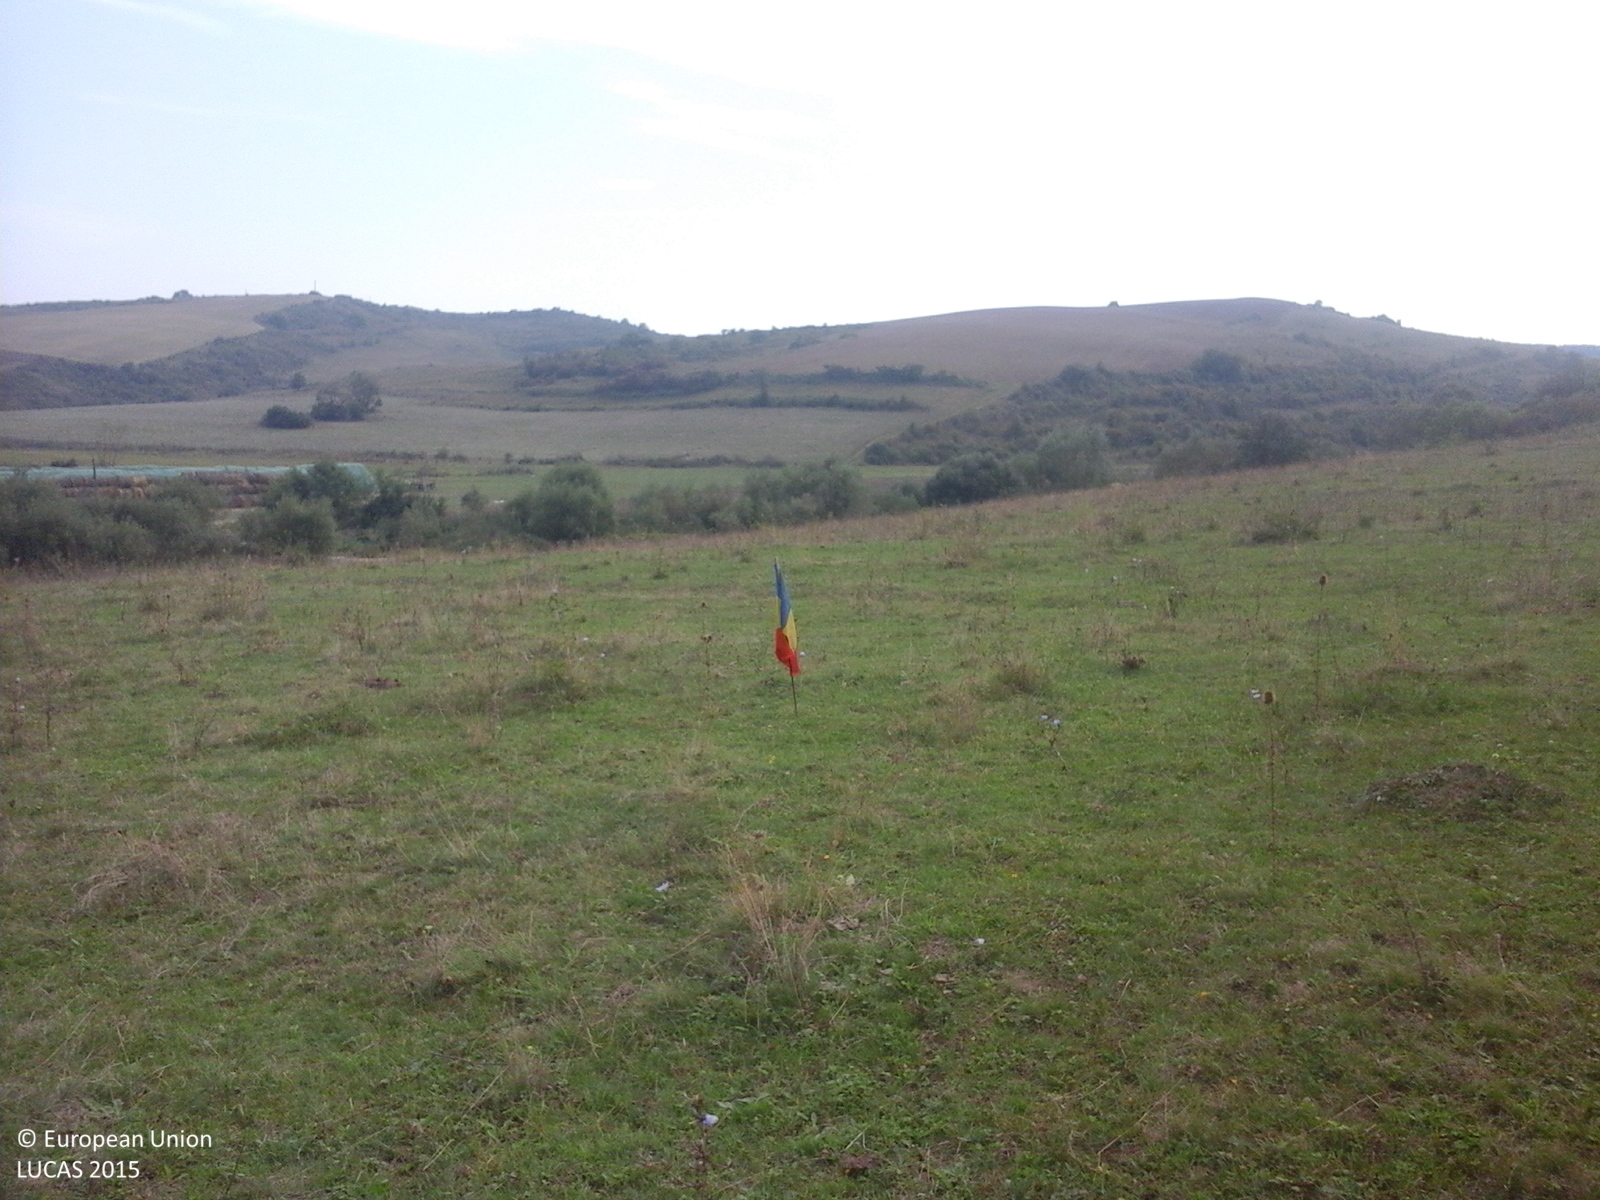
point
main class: Grassland
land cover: Grassland without tree/shrub cover
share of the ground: > 75 %
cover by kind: herbaceous plants 100 %
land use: Agriculture (excluding fallow land and kitchen gardens)
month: September
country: RO
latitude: 47.0249
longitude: 23.3439
